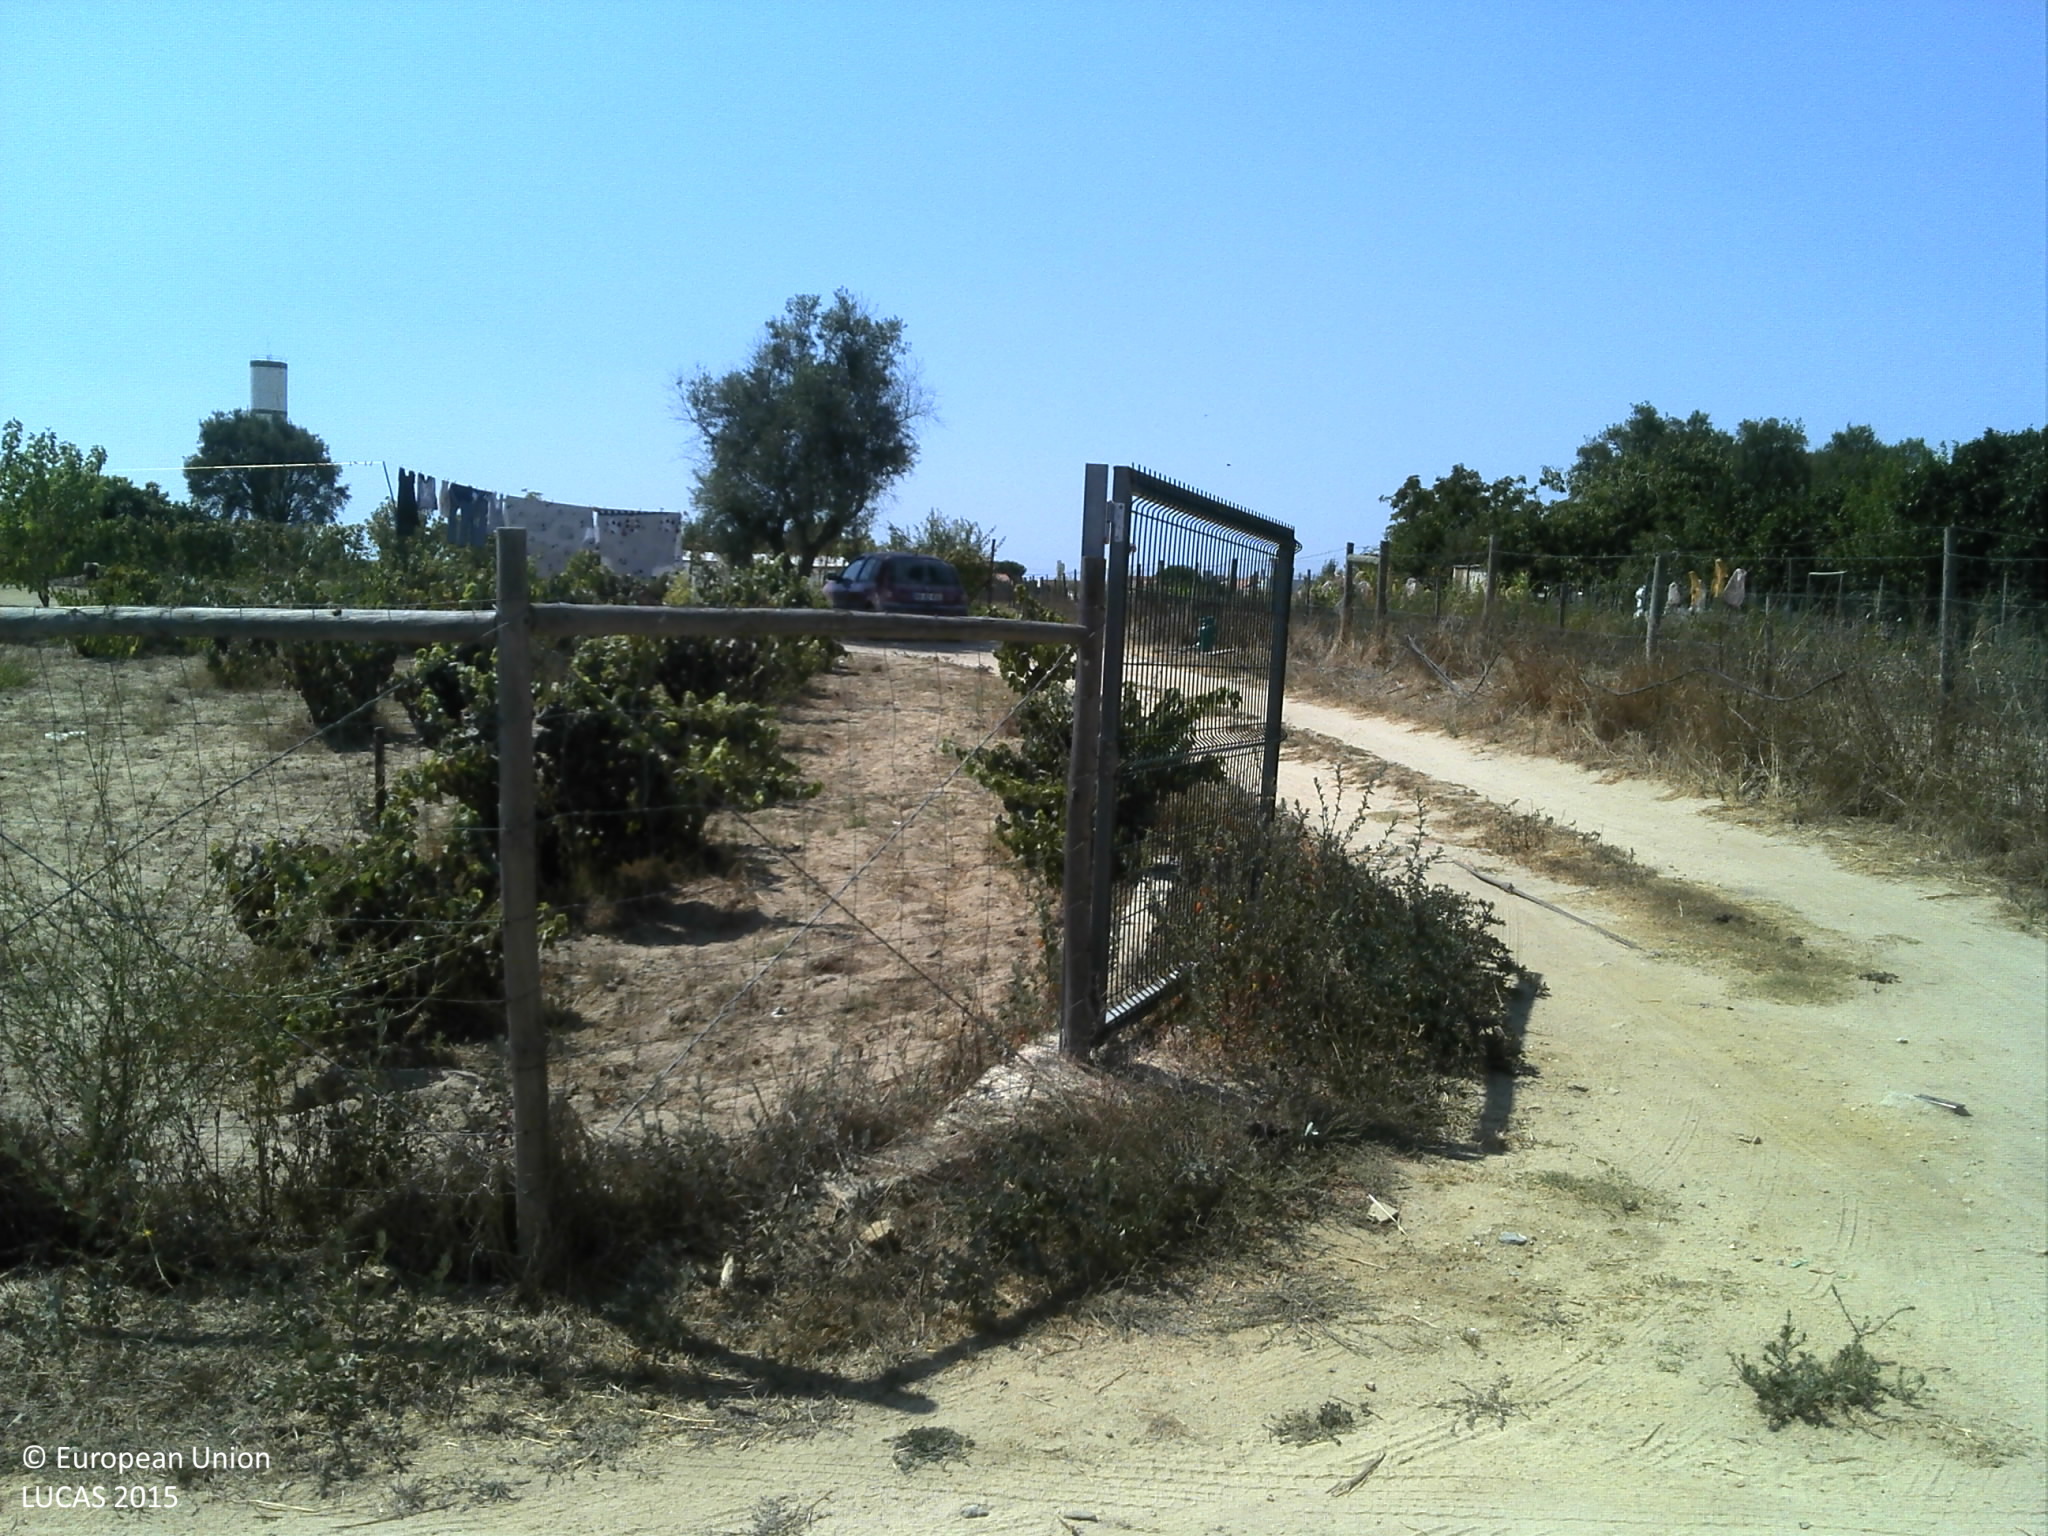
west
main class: Cropland
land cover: Other fruit trees and berries
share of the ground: 25 - 50 %
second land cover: Grassland without tree/shrub cover
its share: 25 - 50 %
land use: Agriculture (excluding fallow land and kitchen gardens)
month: August
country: PT
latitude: 38.6790
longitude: -8.5770
